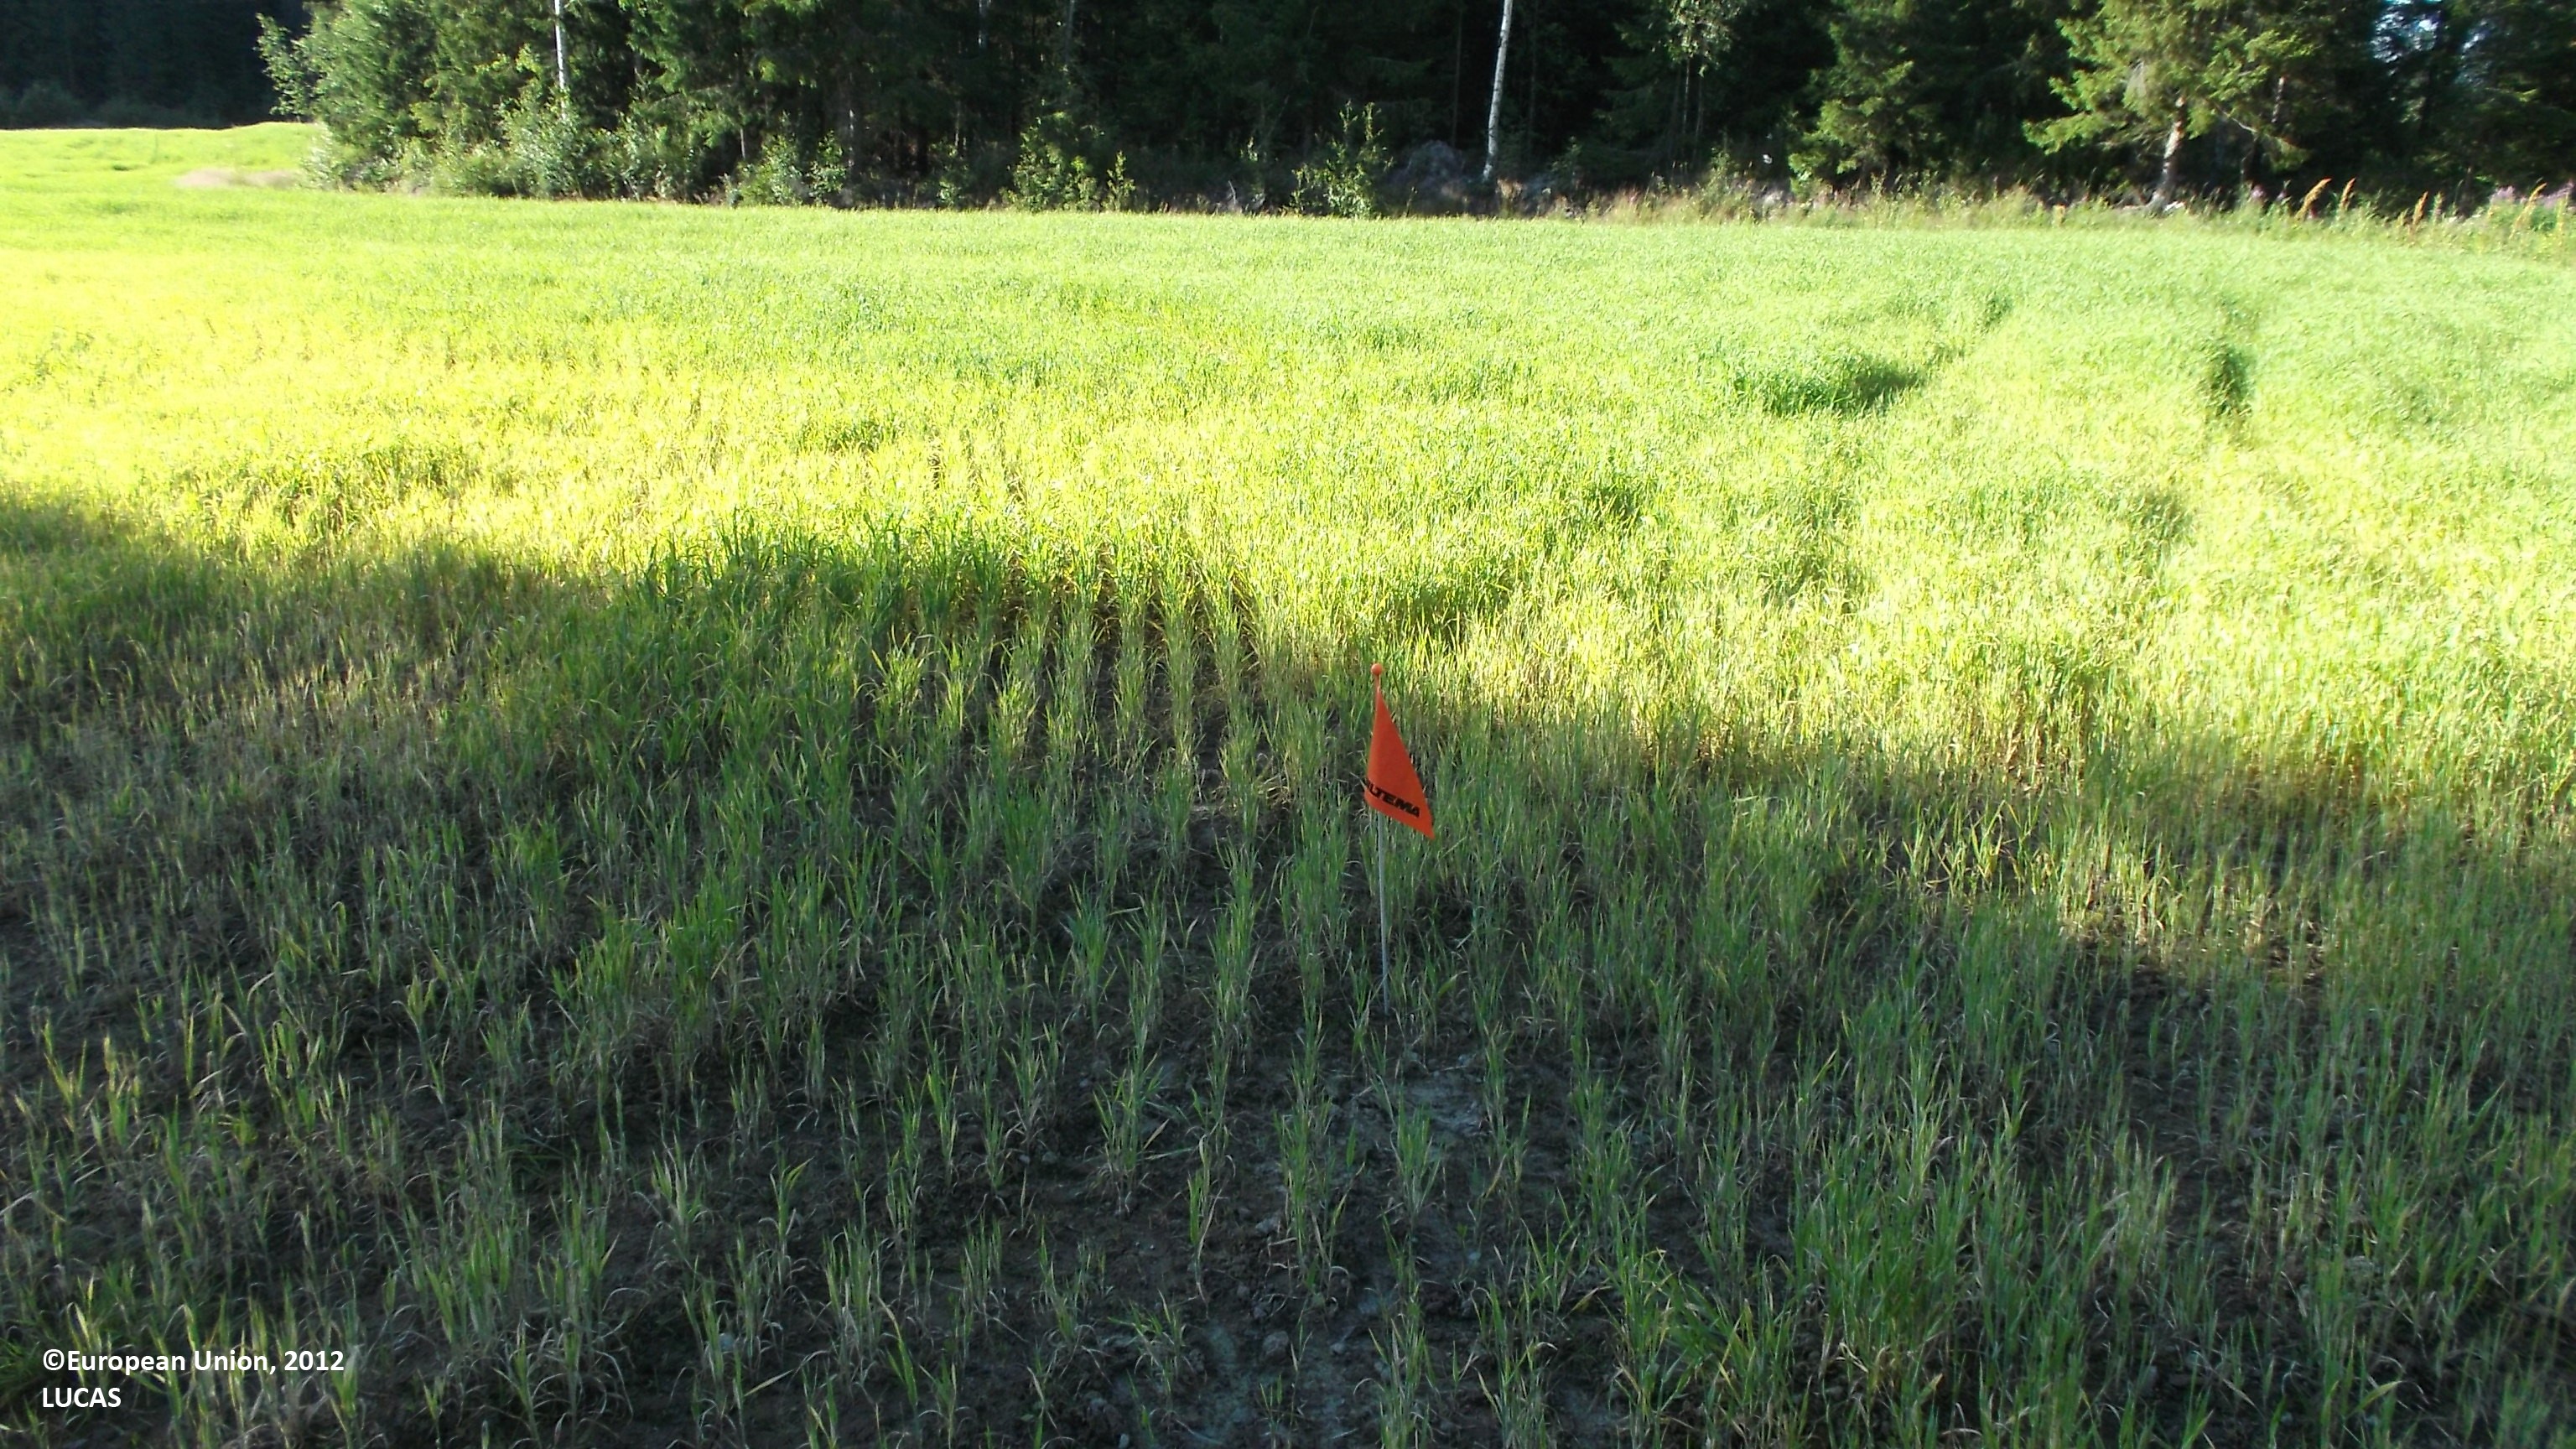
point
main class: Cropland
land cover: Barley
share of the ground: > 75 %
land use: Agriculture (excluding fallow land and kitchen gardens)
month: July
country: FI
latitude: 63.6832
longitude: 22.9299
